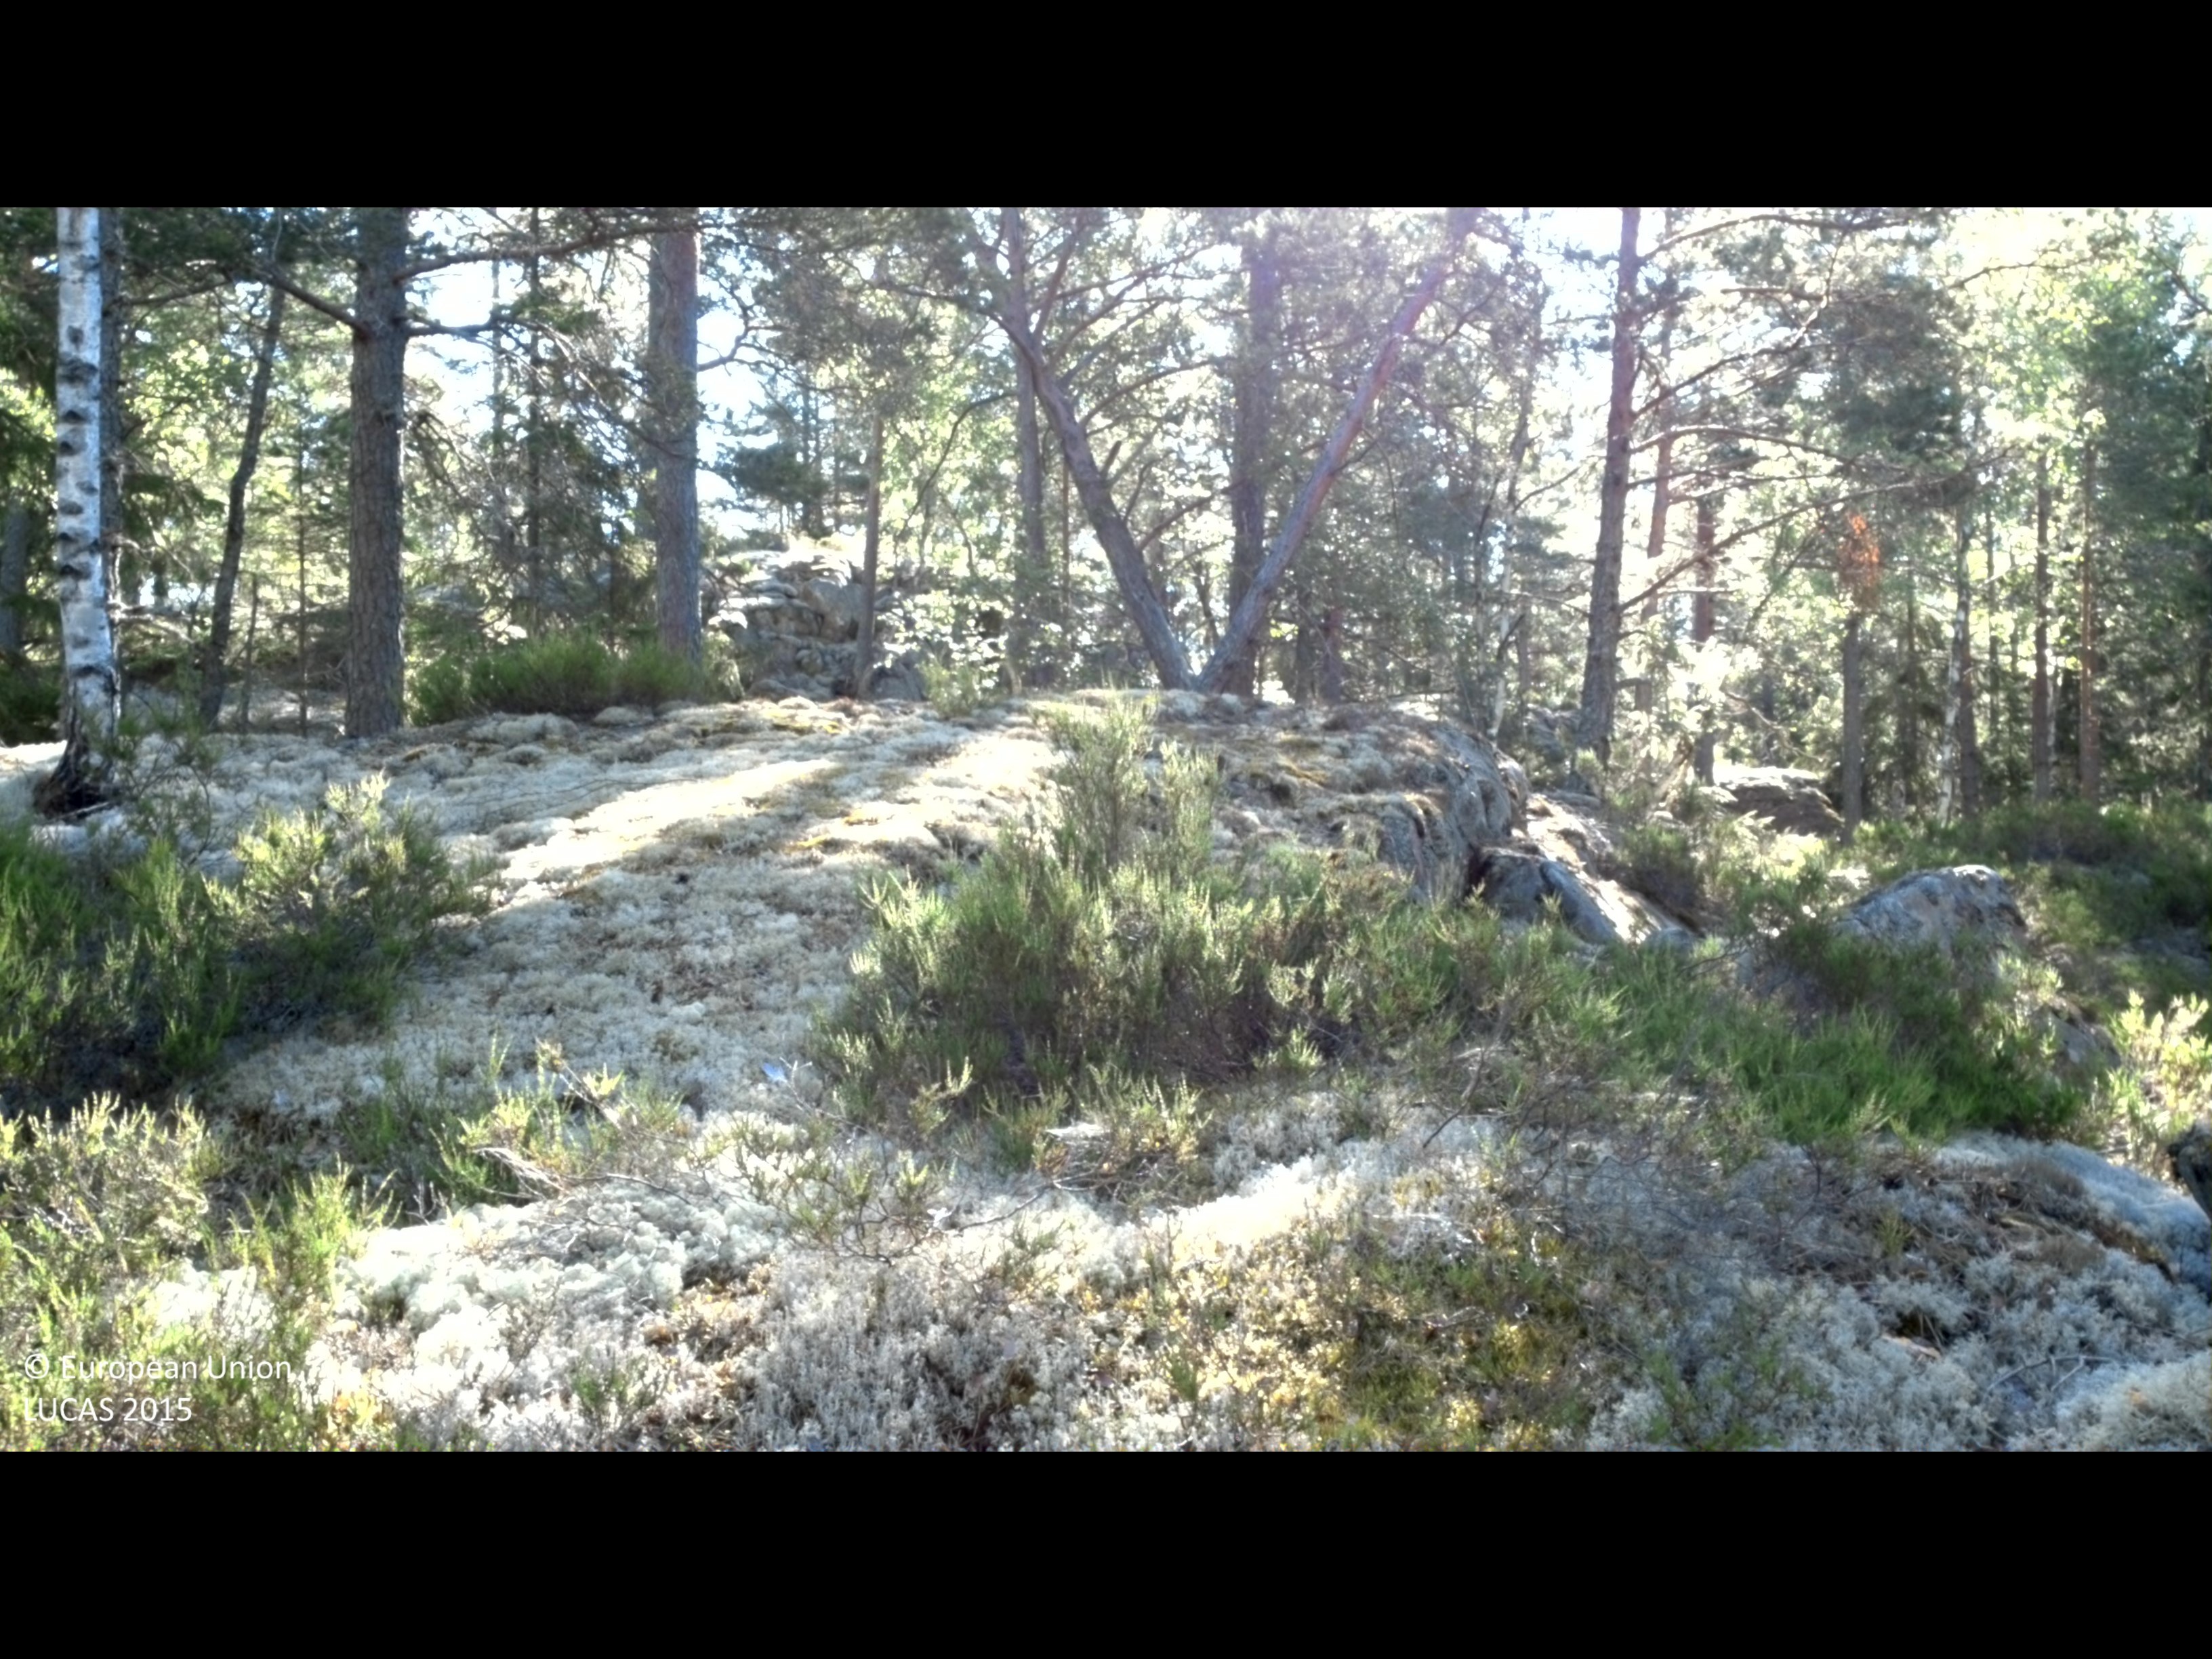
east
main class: Woodland
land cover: Pine dominated coniferous woodland
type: boreal forest
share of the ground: 50 - 75 %
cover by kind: coniferous forest trees 55 %, shrubs 25 %, lichens and mosses 15 %, broadleaved forest trees 5 %
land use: Forestry
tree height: > 5 m
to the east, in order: Pine dominated coniferous woodland; Spruce dominated mixed woodland
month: July
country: SE
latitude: 58.1977
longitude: 16.6838
